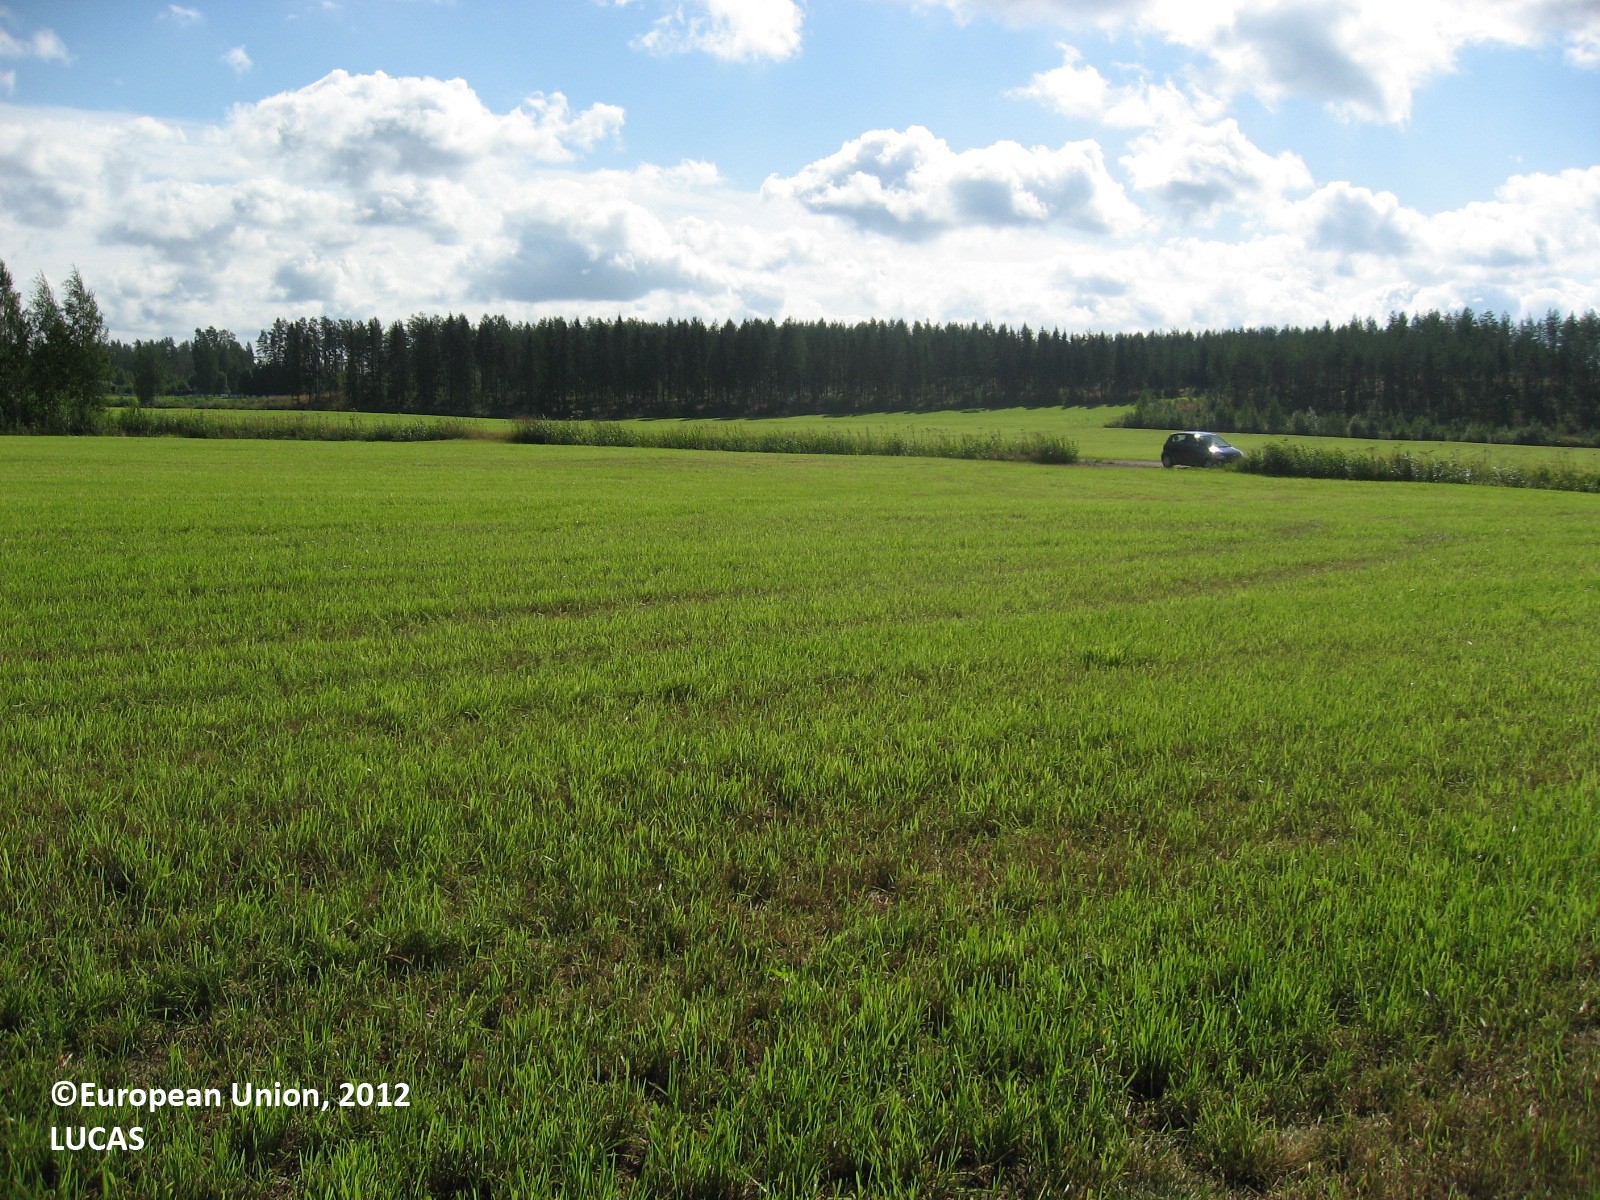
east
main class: Cropland
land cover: Temporary grasslands
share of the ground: > 75 %
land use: Agriculture (excluding fallow land and kitchen gardens)
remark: Harvested field
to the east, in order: Temporary grasslands; Grass margins; Ditches and canals; Grass margins; Ditches and canals; Grass margins; Paved roads, cycling and walking lanes; Temporary grasslands
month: July
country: FI
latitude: 61.2837
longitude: 26.5123
